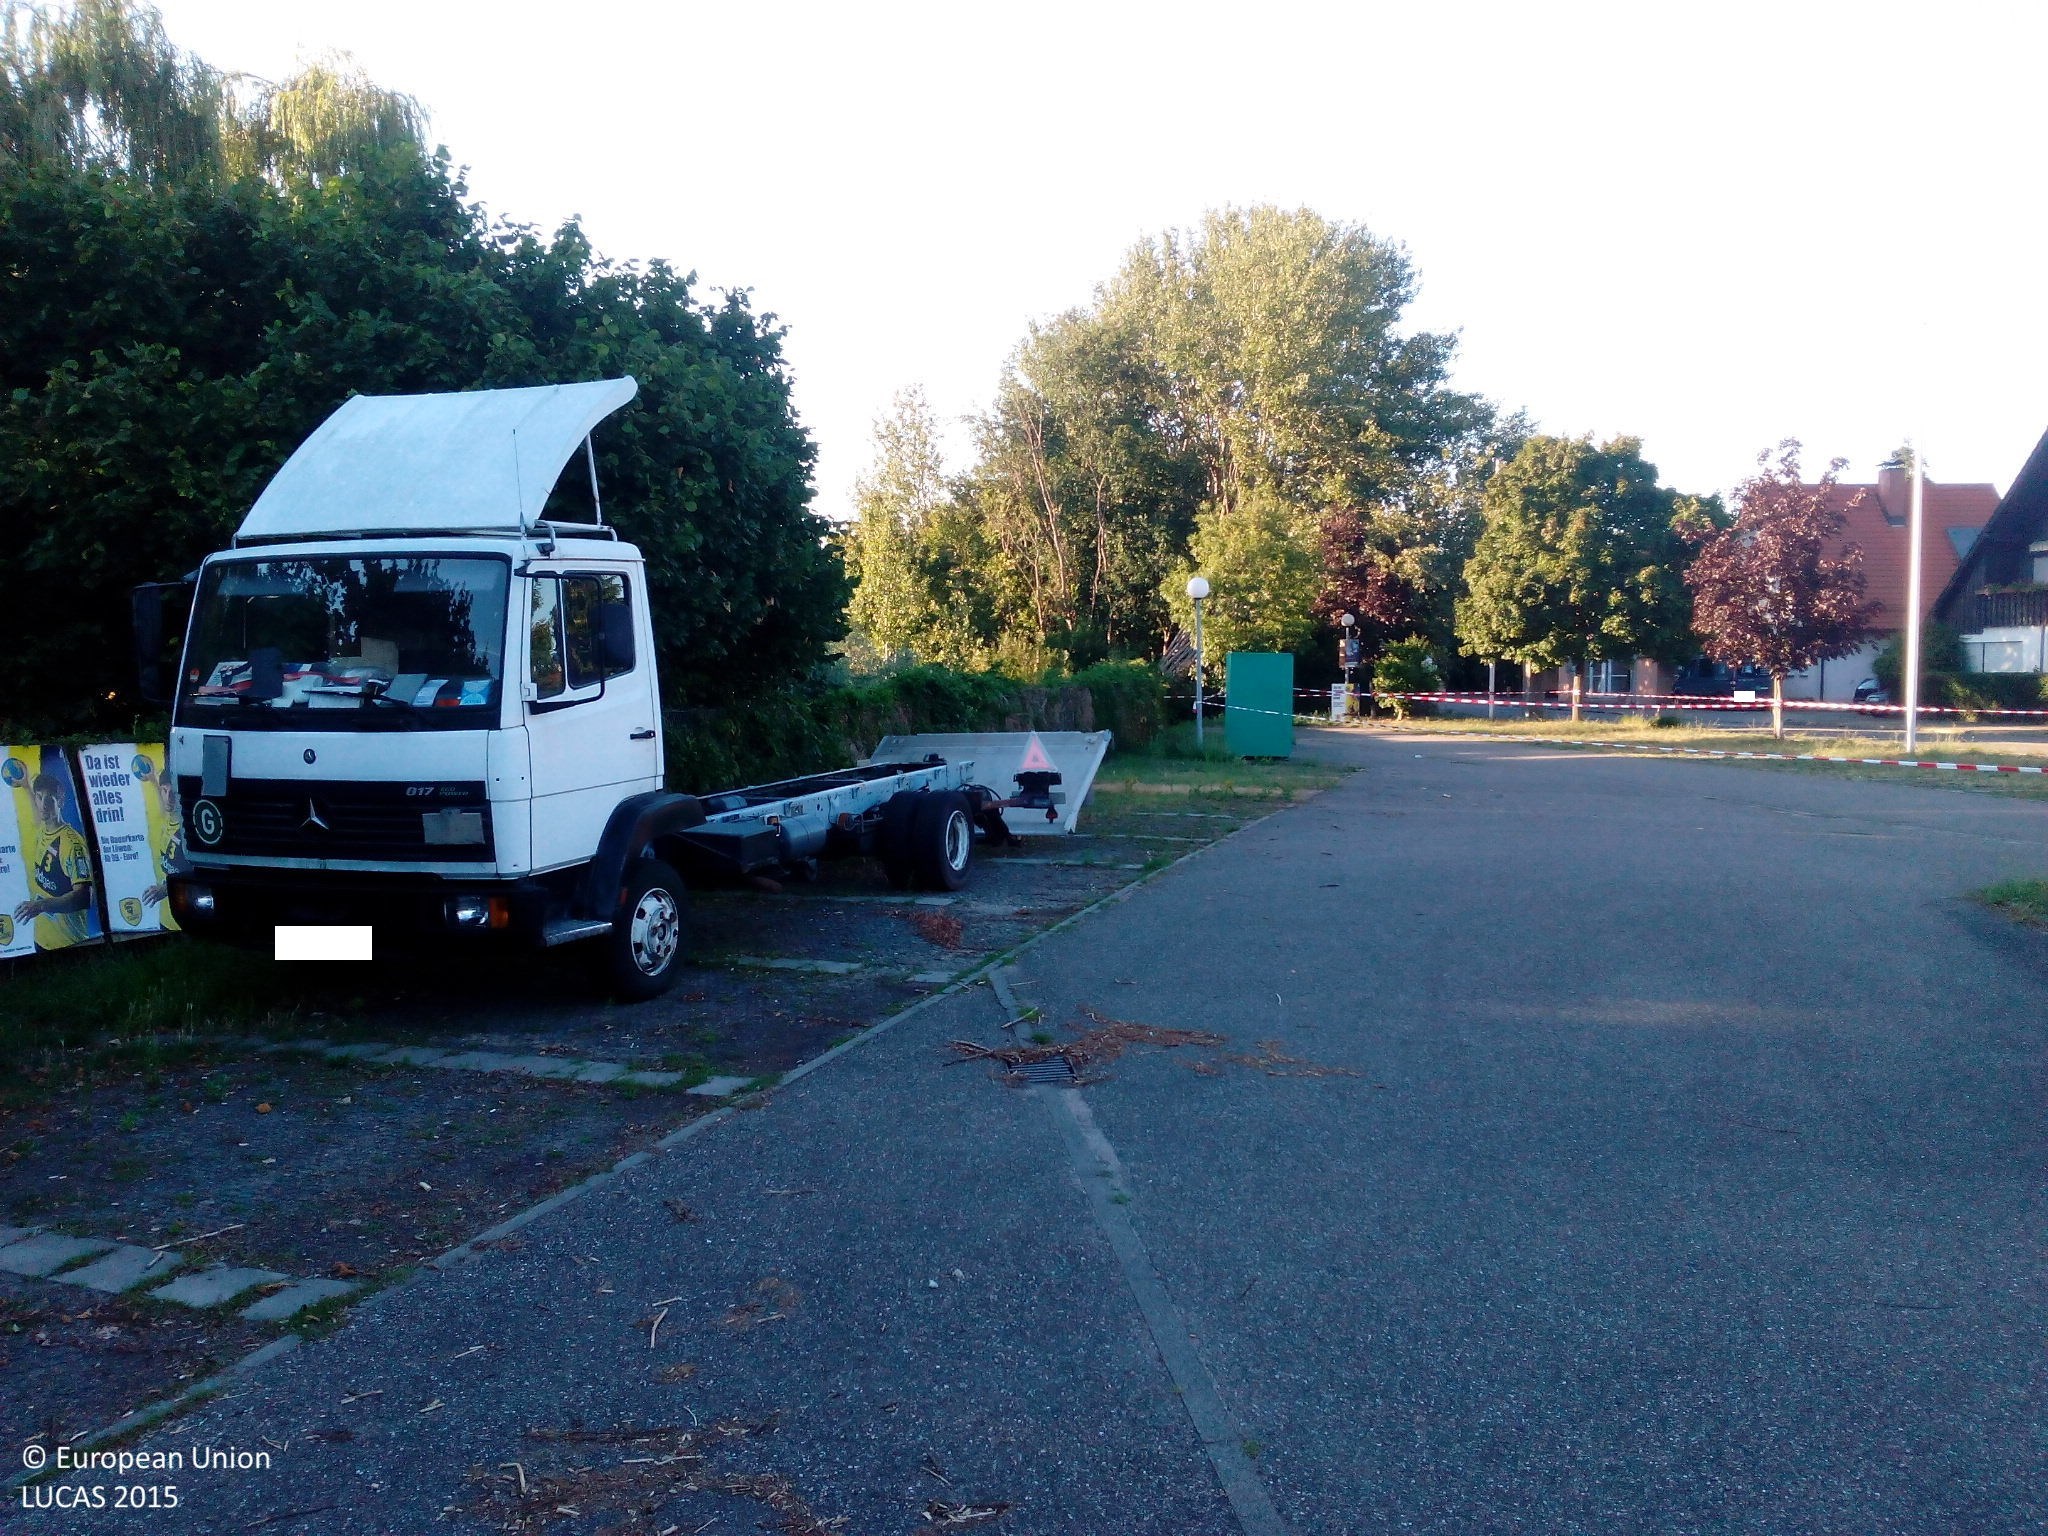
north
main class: Woodland
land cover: Broadleaved woodland
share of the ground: > 75 %
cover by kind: broadleaved forest trees 60 %, shrubs 20 %, herbaceous plants 20 %
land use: Semi-natural and natural areas not in use
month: August
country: DE
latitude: 49.4192
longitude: 8.5255
